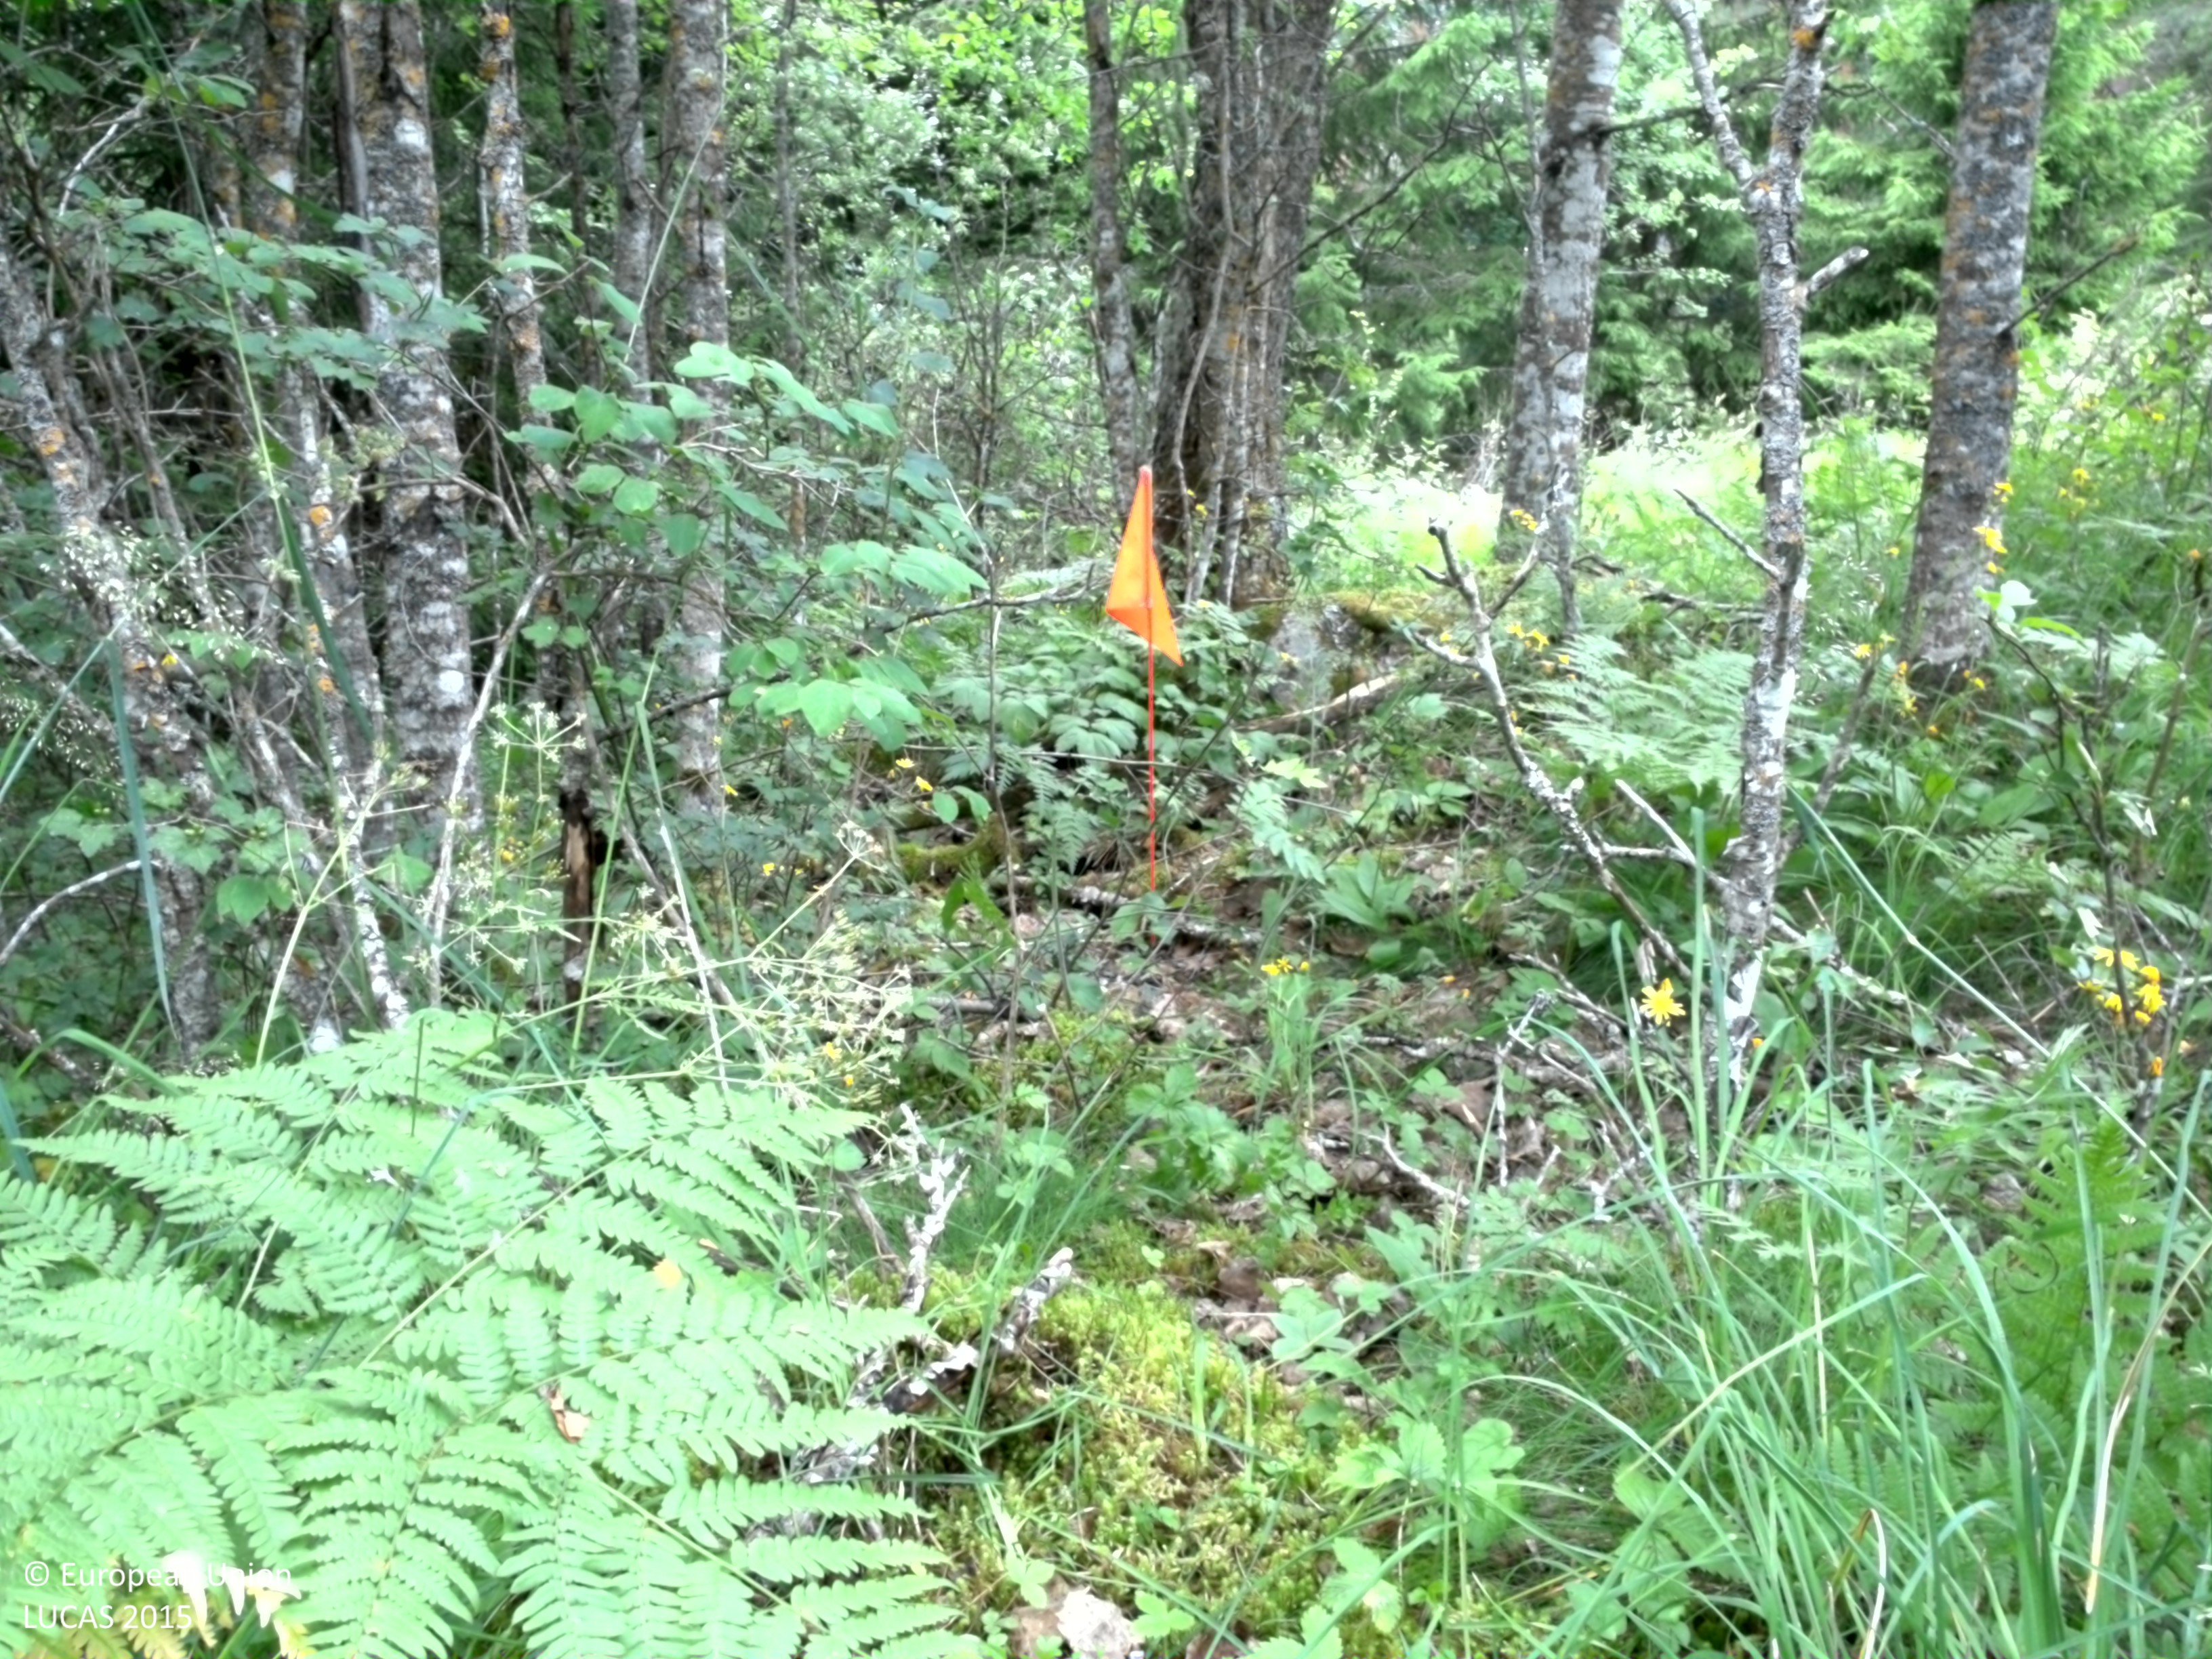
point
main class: Woodland
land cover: Broadleaved woodland
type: boreal forest
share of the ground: > 75 %
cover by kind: broadleaved forest trees 65 %, coniferous forest trees 20 %, herbaceous plants 15 %
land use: Forestry
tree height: > 5 m
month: July
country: SE
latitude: 59.7645
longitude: 17.4896
